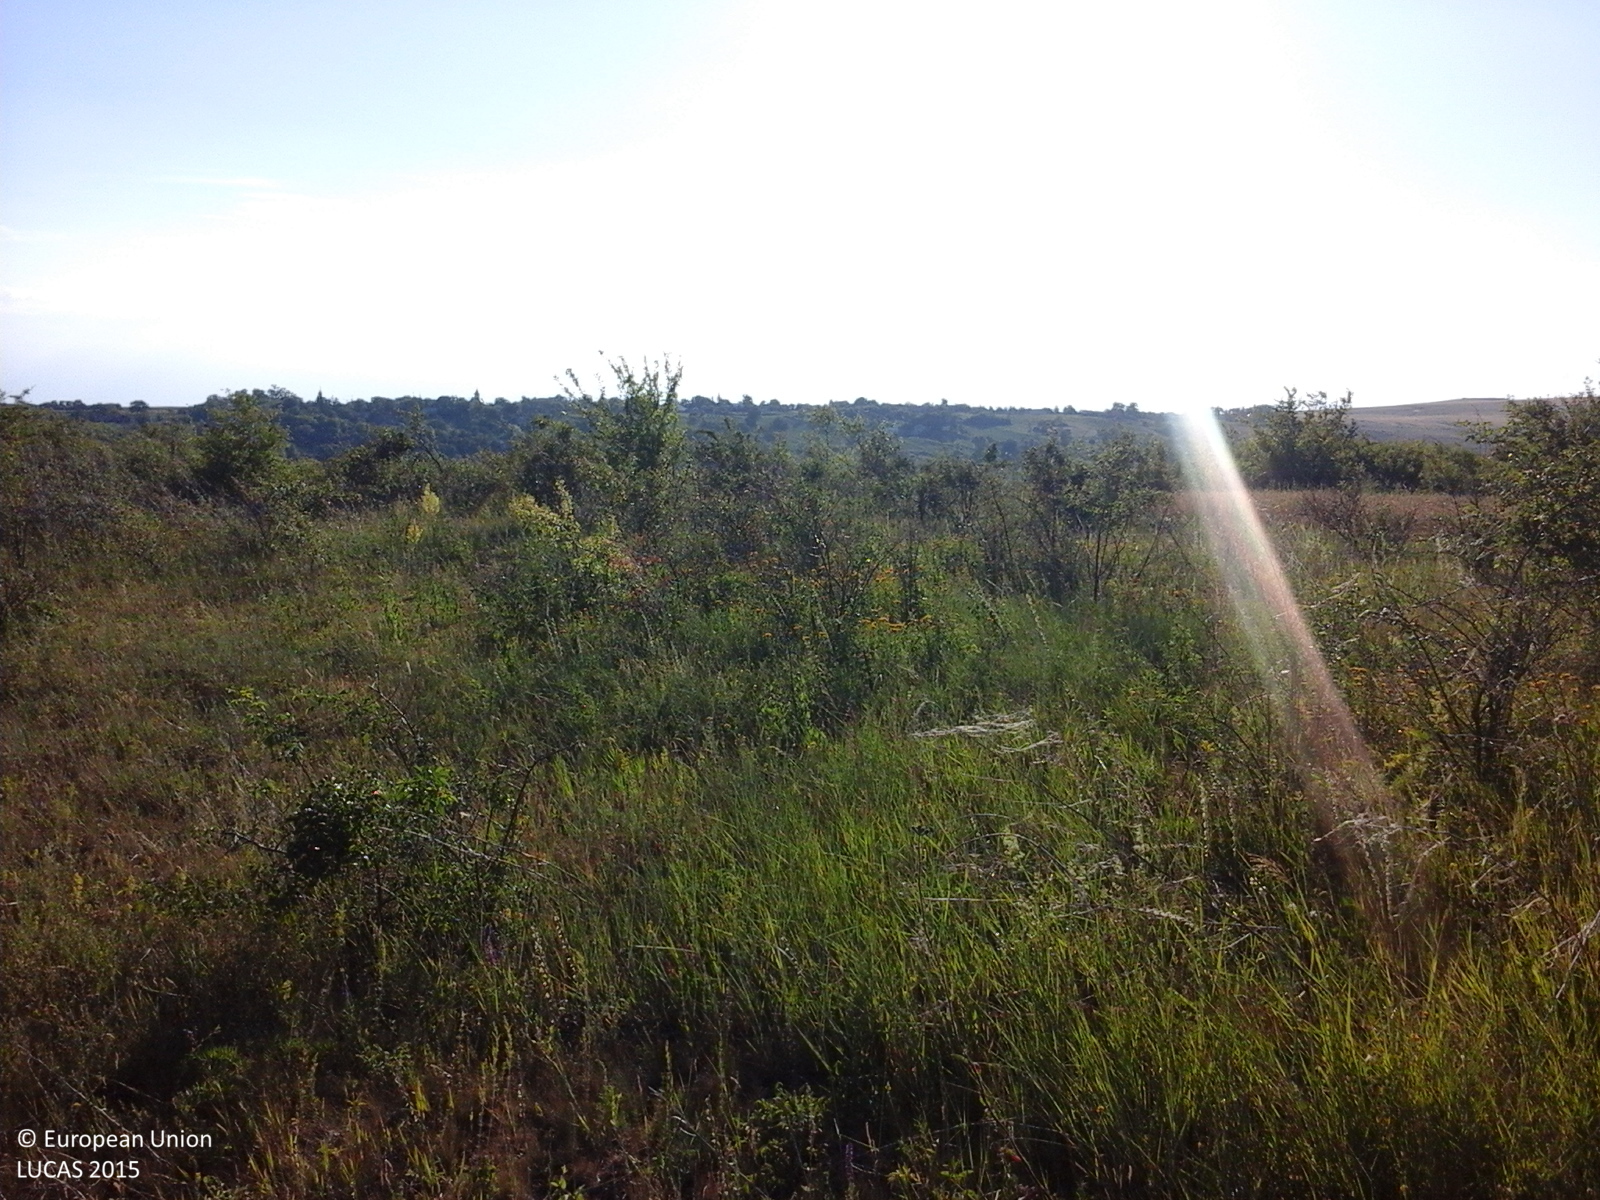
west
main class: Shrubland
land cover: Shrubland with sparse tree cover
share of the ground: > 75 %
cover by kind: herbaceous plants 50 %, shrubs 45 %, broadleaved forest trees 5 %
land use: Agriculture (excluding fallow land and kitchen gardens)
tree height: < 5 m
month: June
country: RO
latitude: 46.9305
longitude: 27.5444
